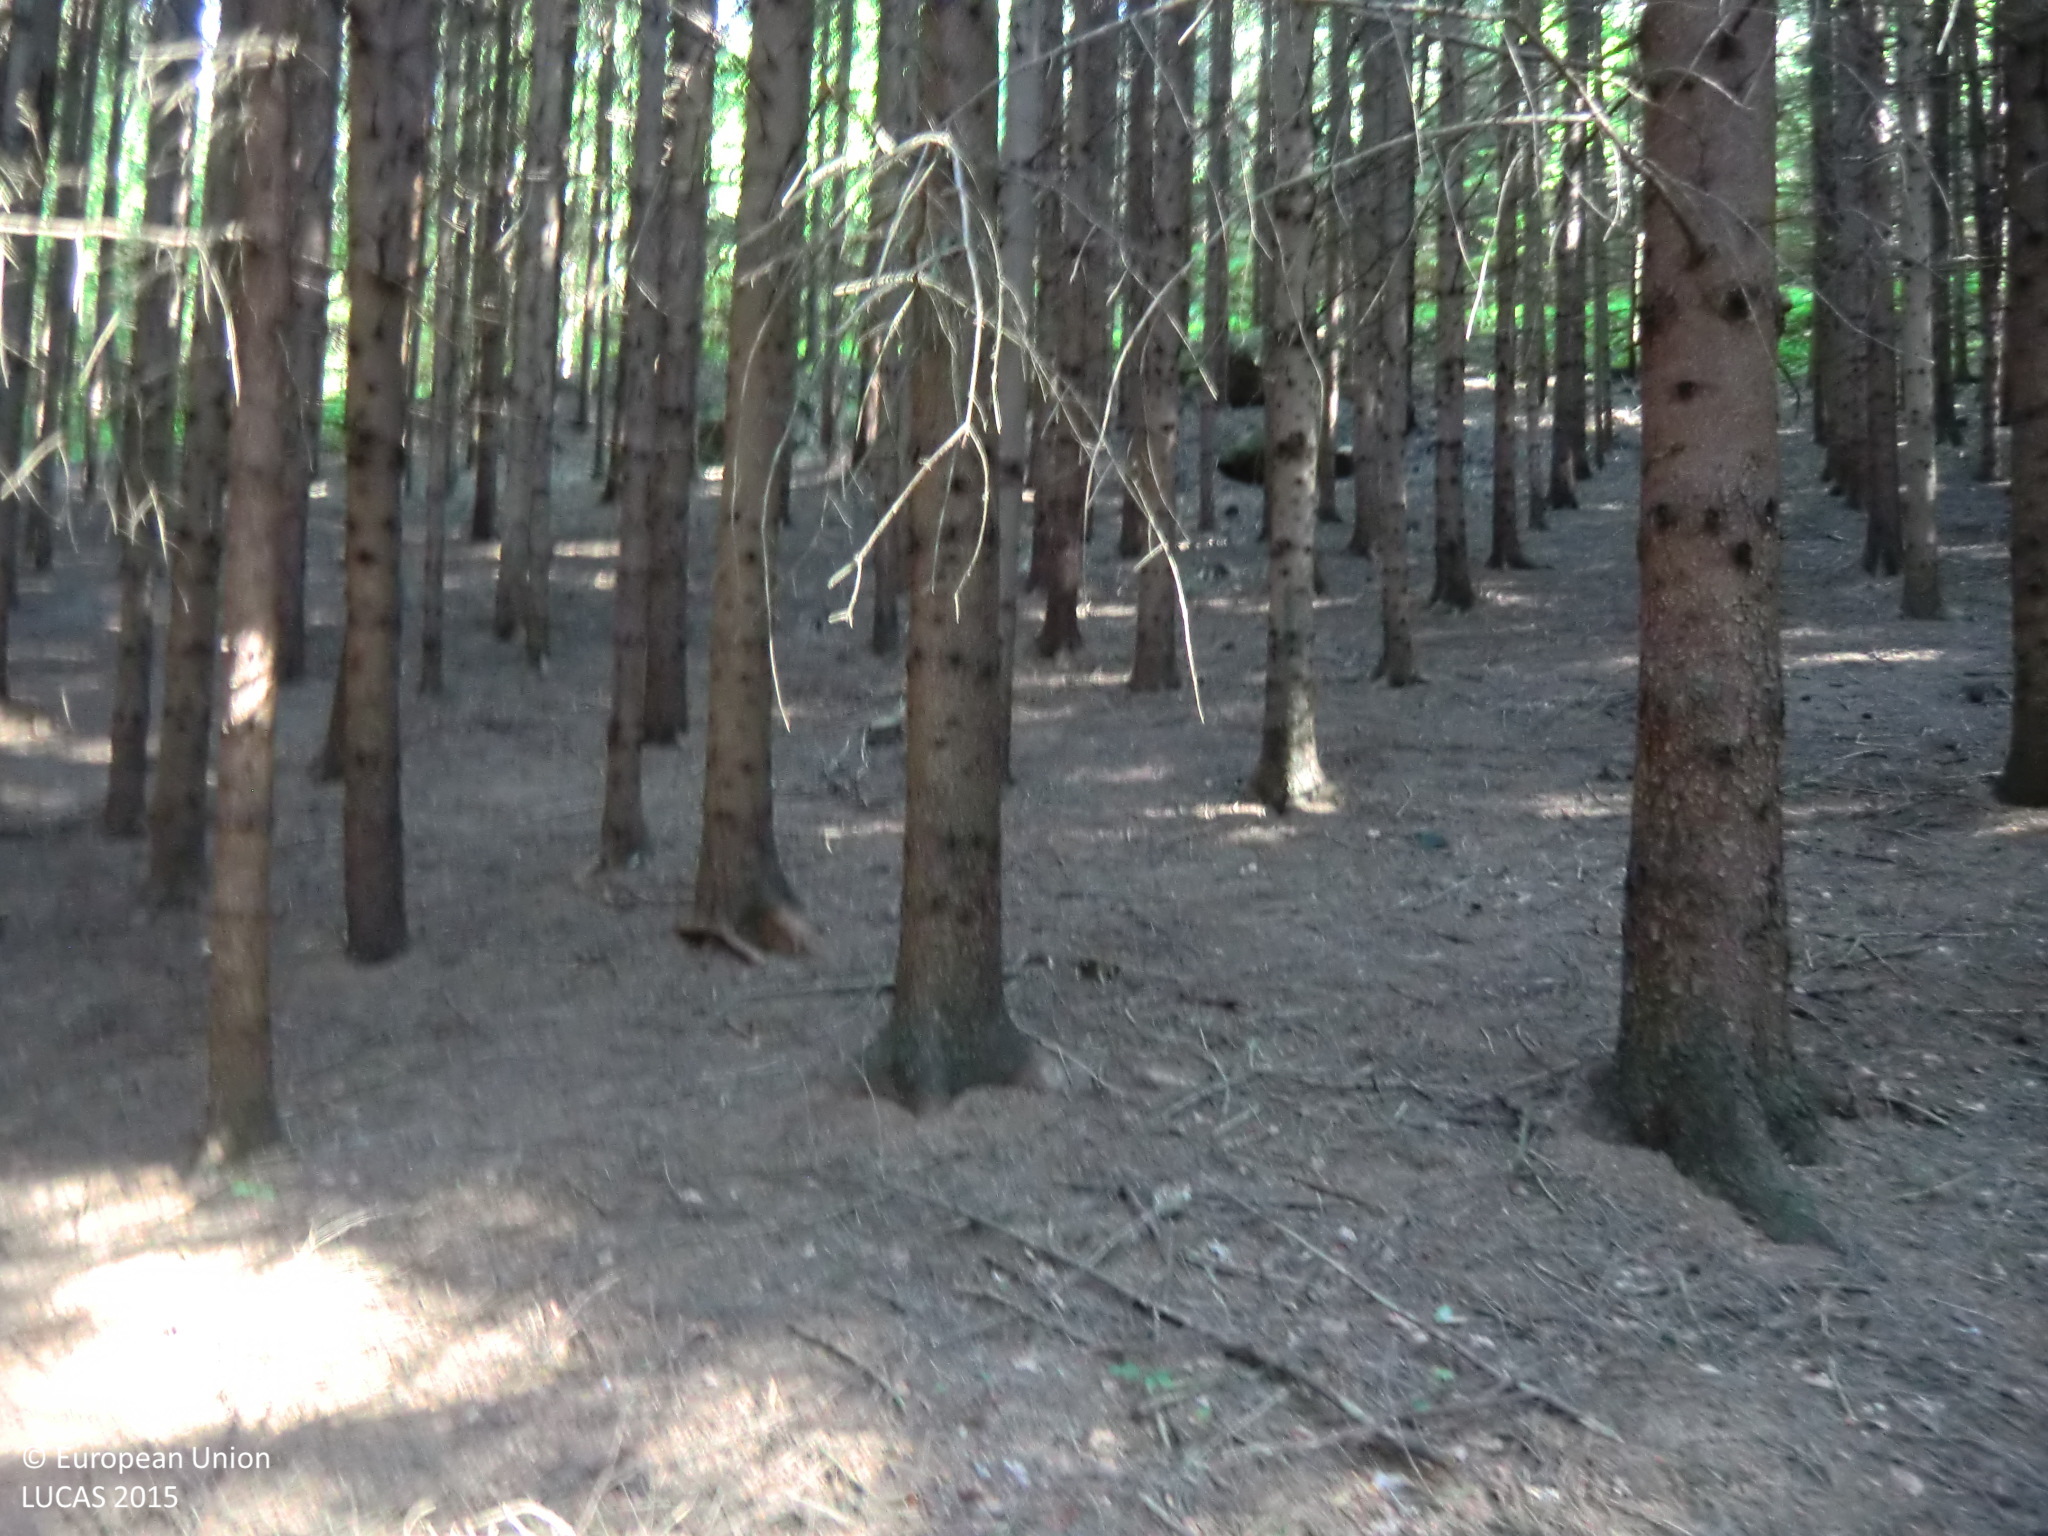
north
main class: Woodland
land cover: Spruce dominated coniferous woodland
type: hemiboreal forest and nemoral coniferous forest and mixed broadleaved-coniferous forest
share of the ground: > 75 %
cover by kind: coniferous forest trees 80 %, unconsolidated bare surface 20 %
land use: Forestry
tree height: > 5 m
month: June
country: AT
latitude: 48.2724
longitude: 15.0000
